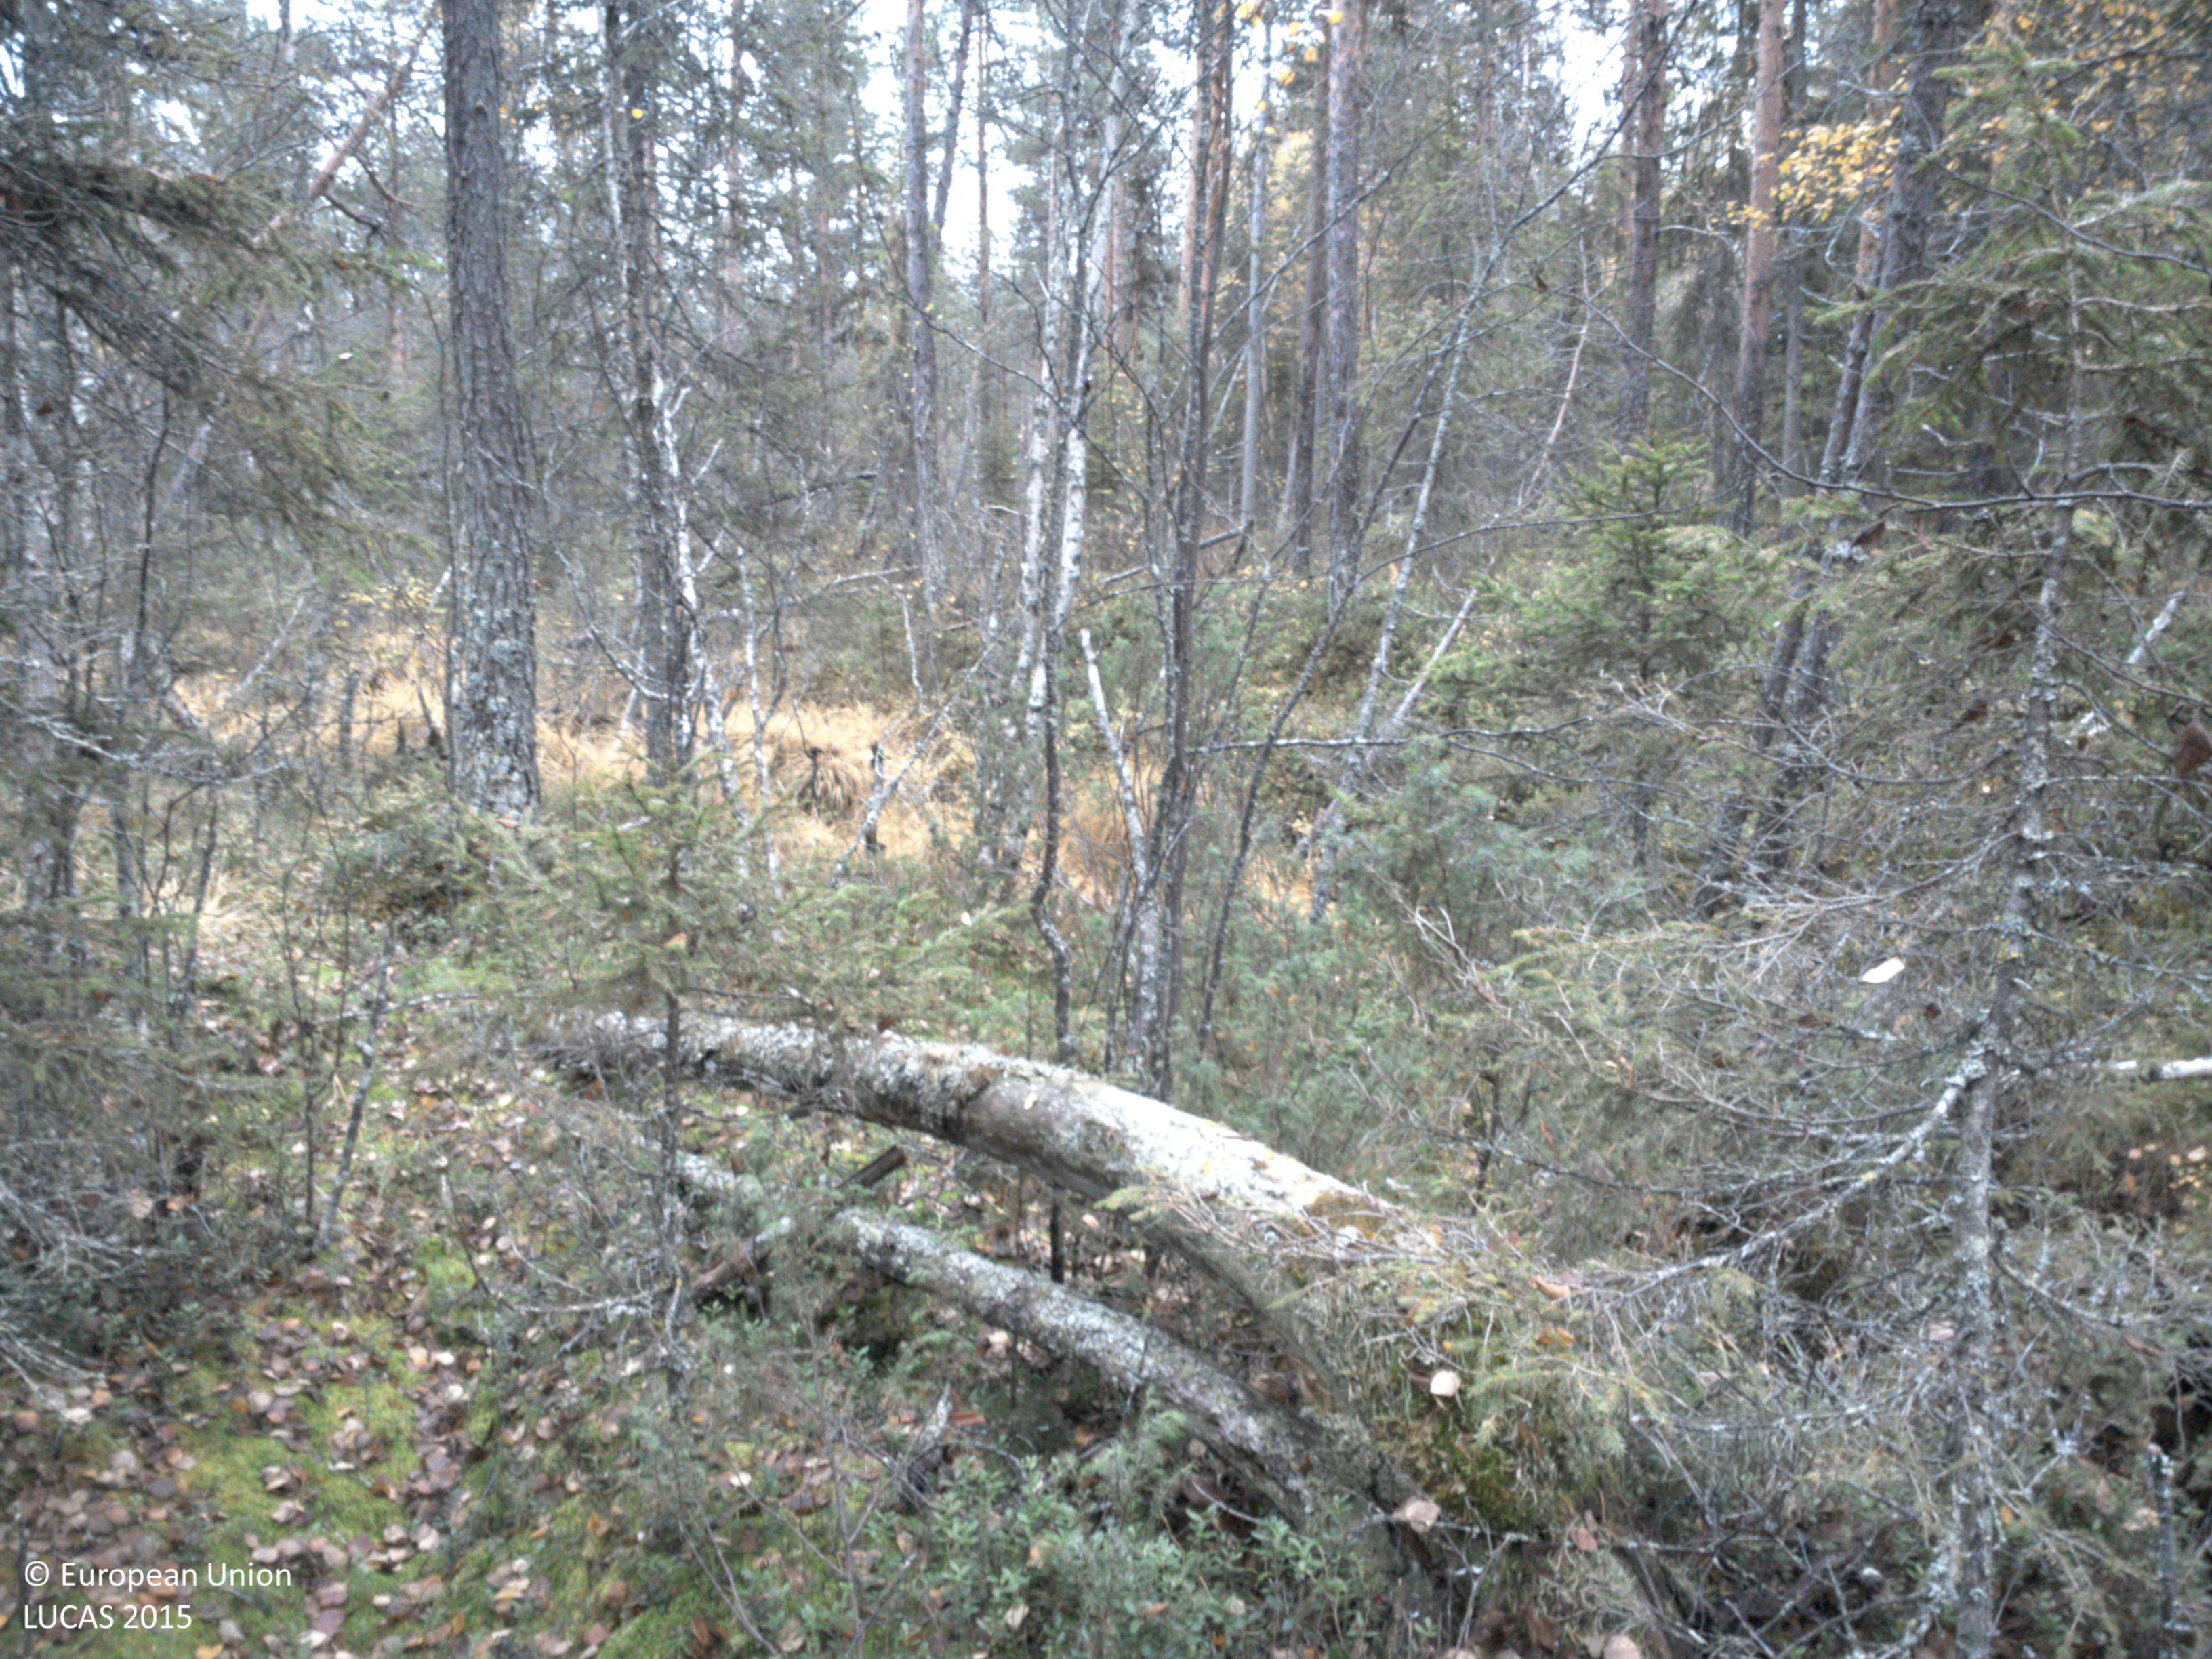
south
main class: Woodland
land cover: Pine dominated mixed woodland
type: boreal forest
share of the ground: > 75 %
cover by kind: coniferous forest trees 60 %, broadleaved forest trees 20 %, shrubs 10 %, herbaceous plants 5 %, lichens and mosses 5 %
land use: Forestry
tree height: > 5 m
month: September
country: SE
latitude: 64.8404
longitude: 18.8837
